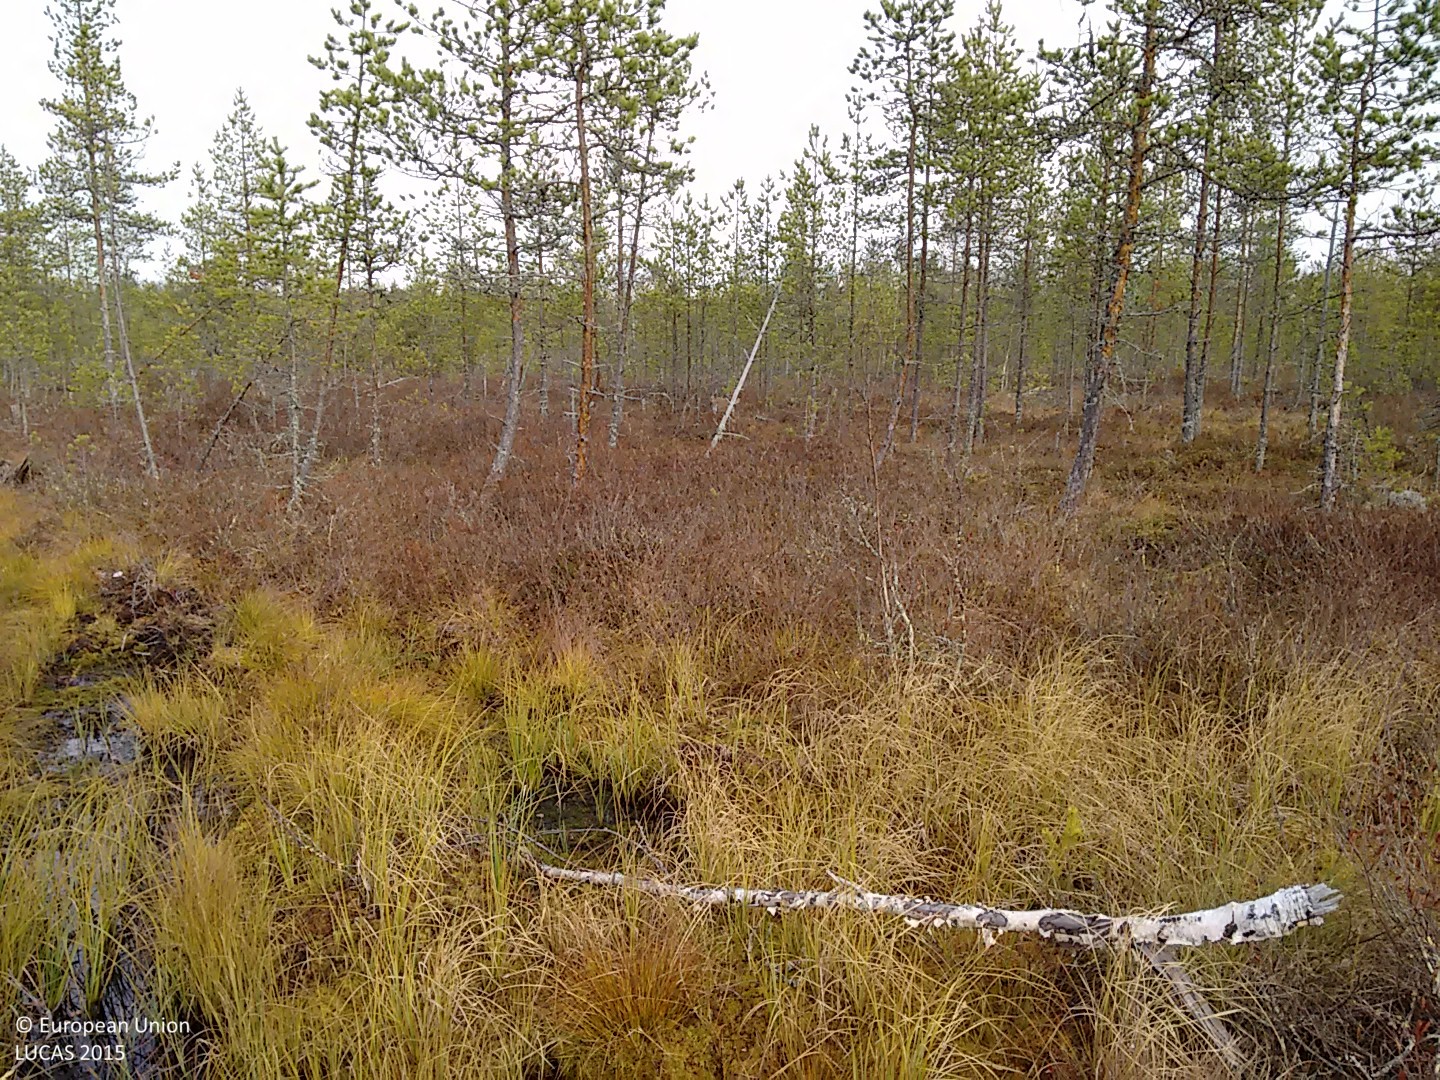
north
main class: Woodland
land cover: Pine dominated coniferous woodland
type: boreal forest
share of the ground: 25 - 50 %
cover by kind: coniferous forest trees 45 %, shrubs 25 %, herbaceous plants 25 %, lichens and mosses 5 %
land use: Forestry
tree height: > 5 m
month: October
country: FI
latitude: 64.3938
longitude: 24.8637
